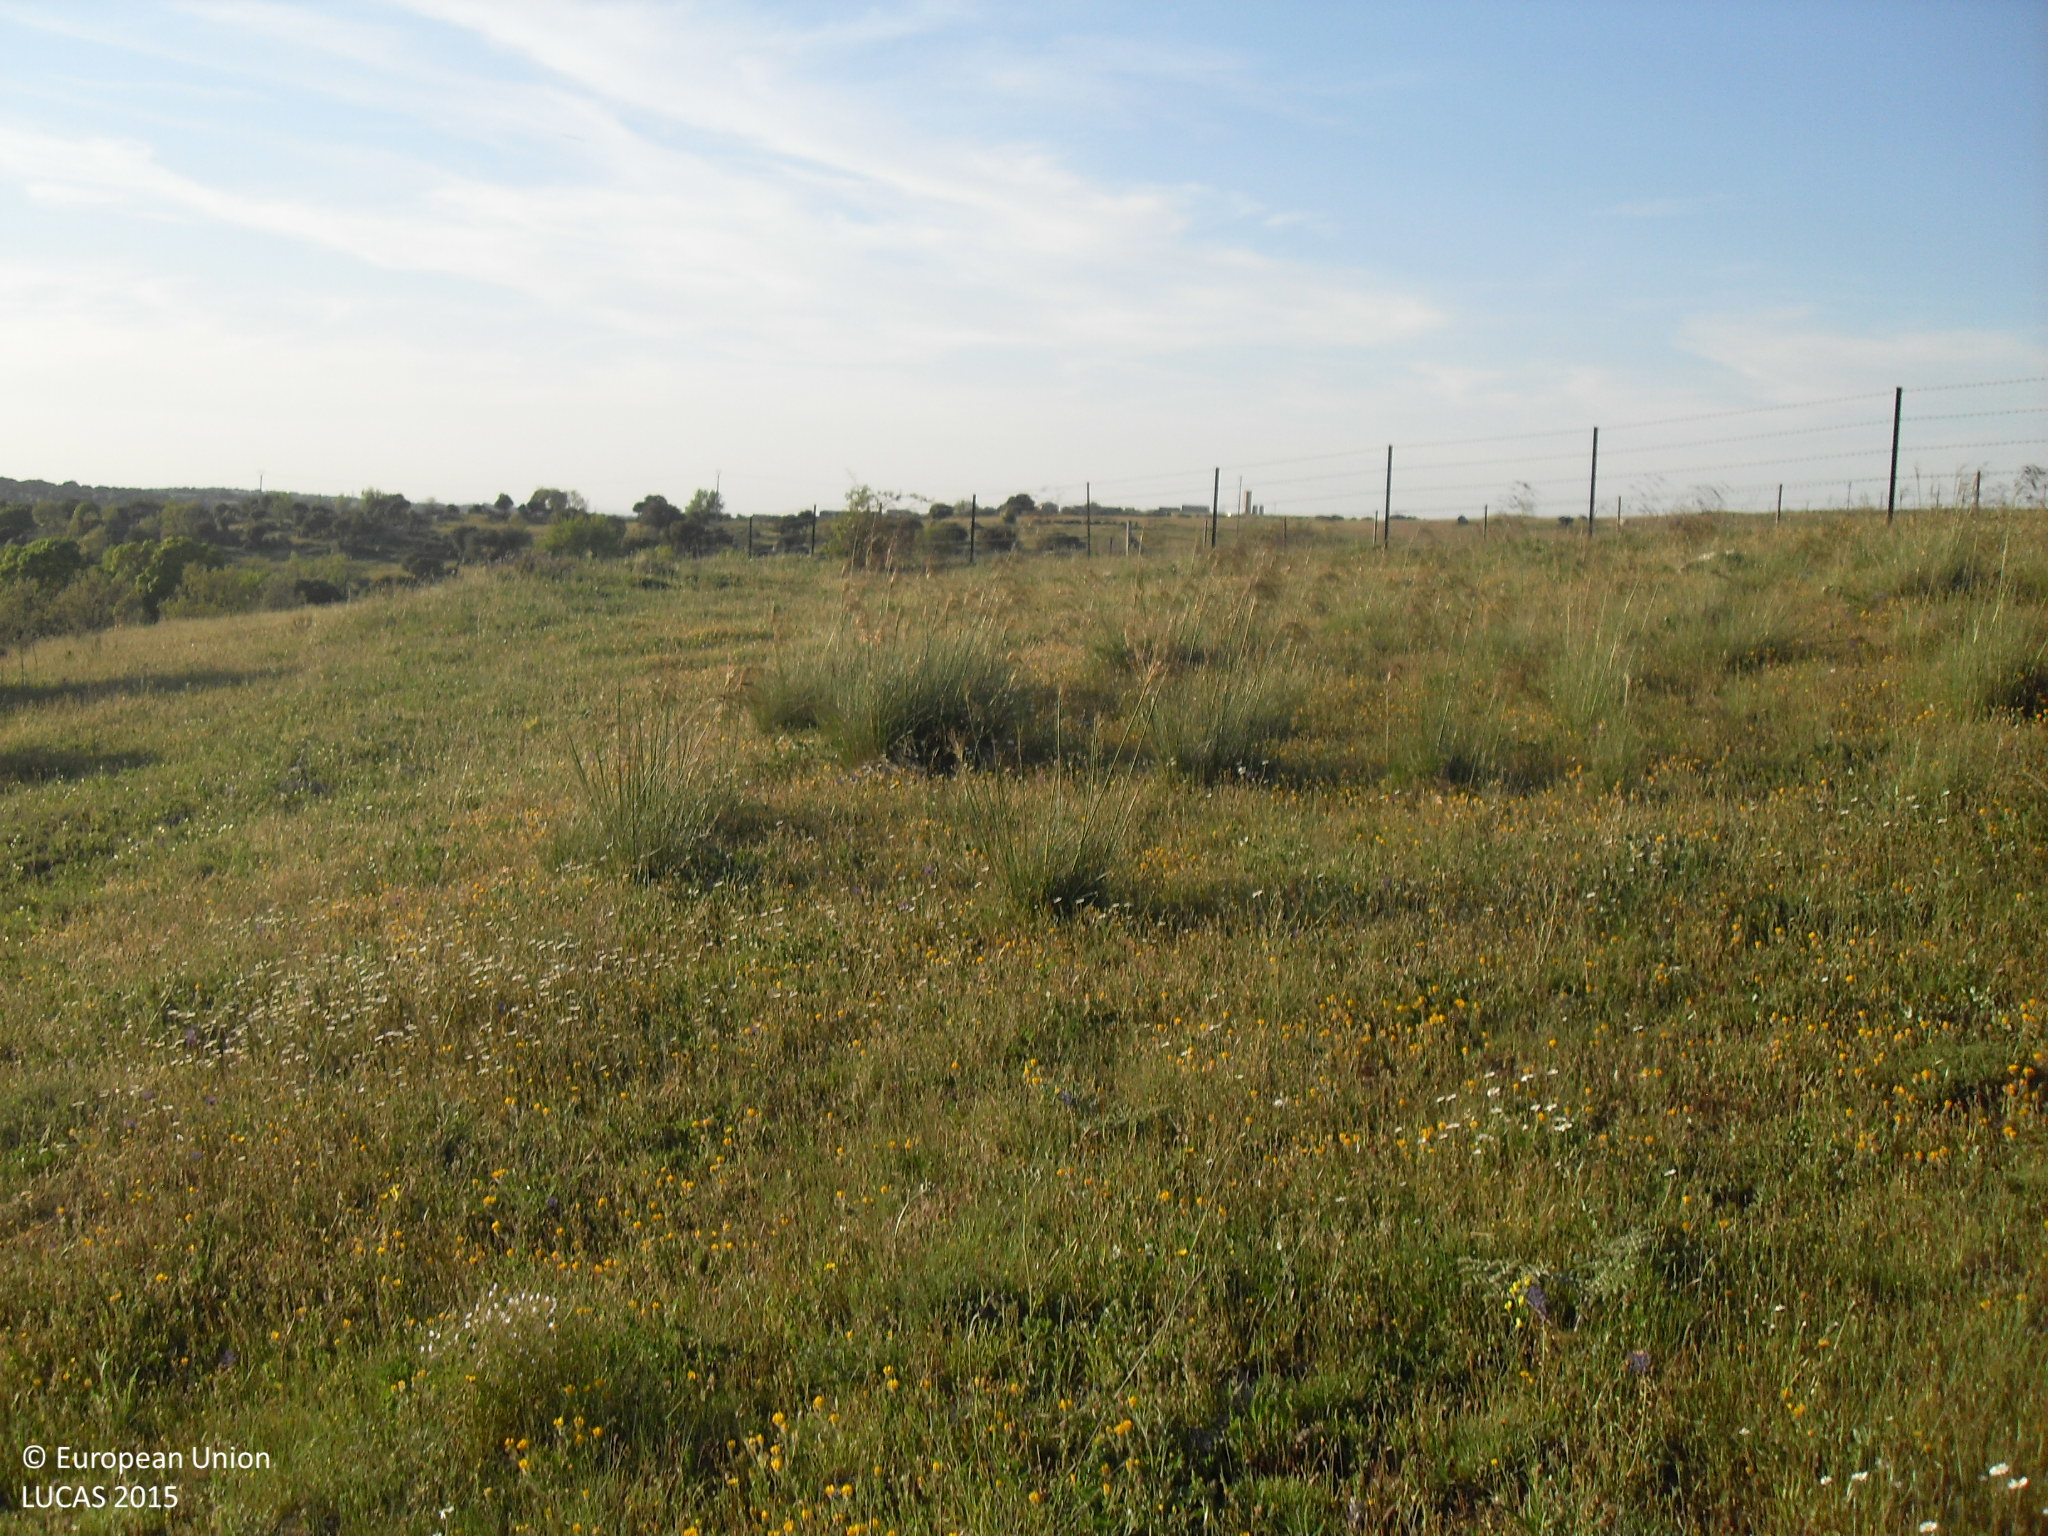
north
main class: Grassland
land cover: Grassland with sparse tree/shrub cover
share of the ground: > 75 %
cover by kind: herbaceous plants 95 %, broadleaved forest trees 5 %
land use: Agriculture (excluding fallow land and kitchen gardens)
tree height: < 5 m
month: May
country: ES
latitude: 40.6884
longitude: -5.1025
